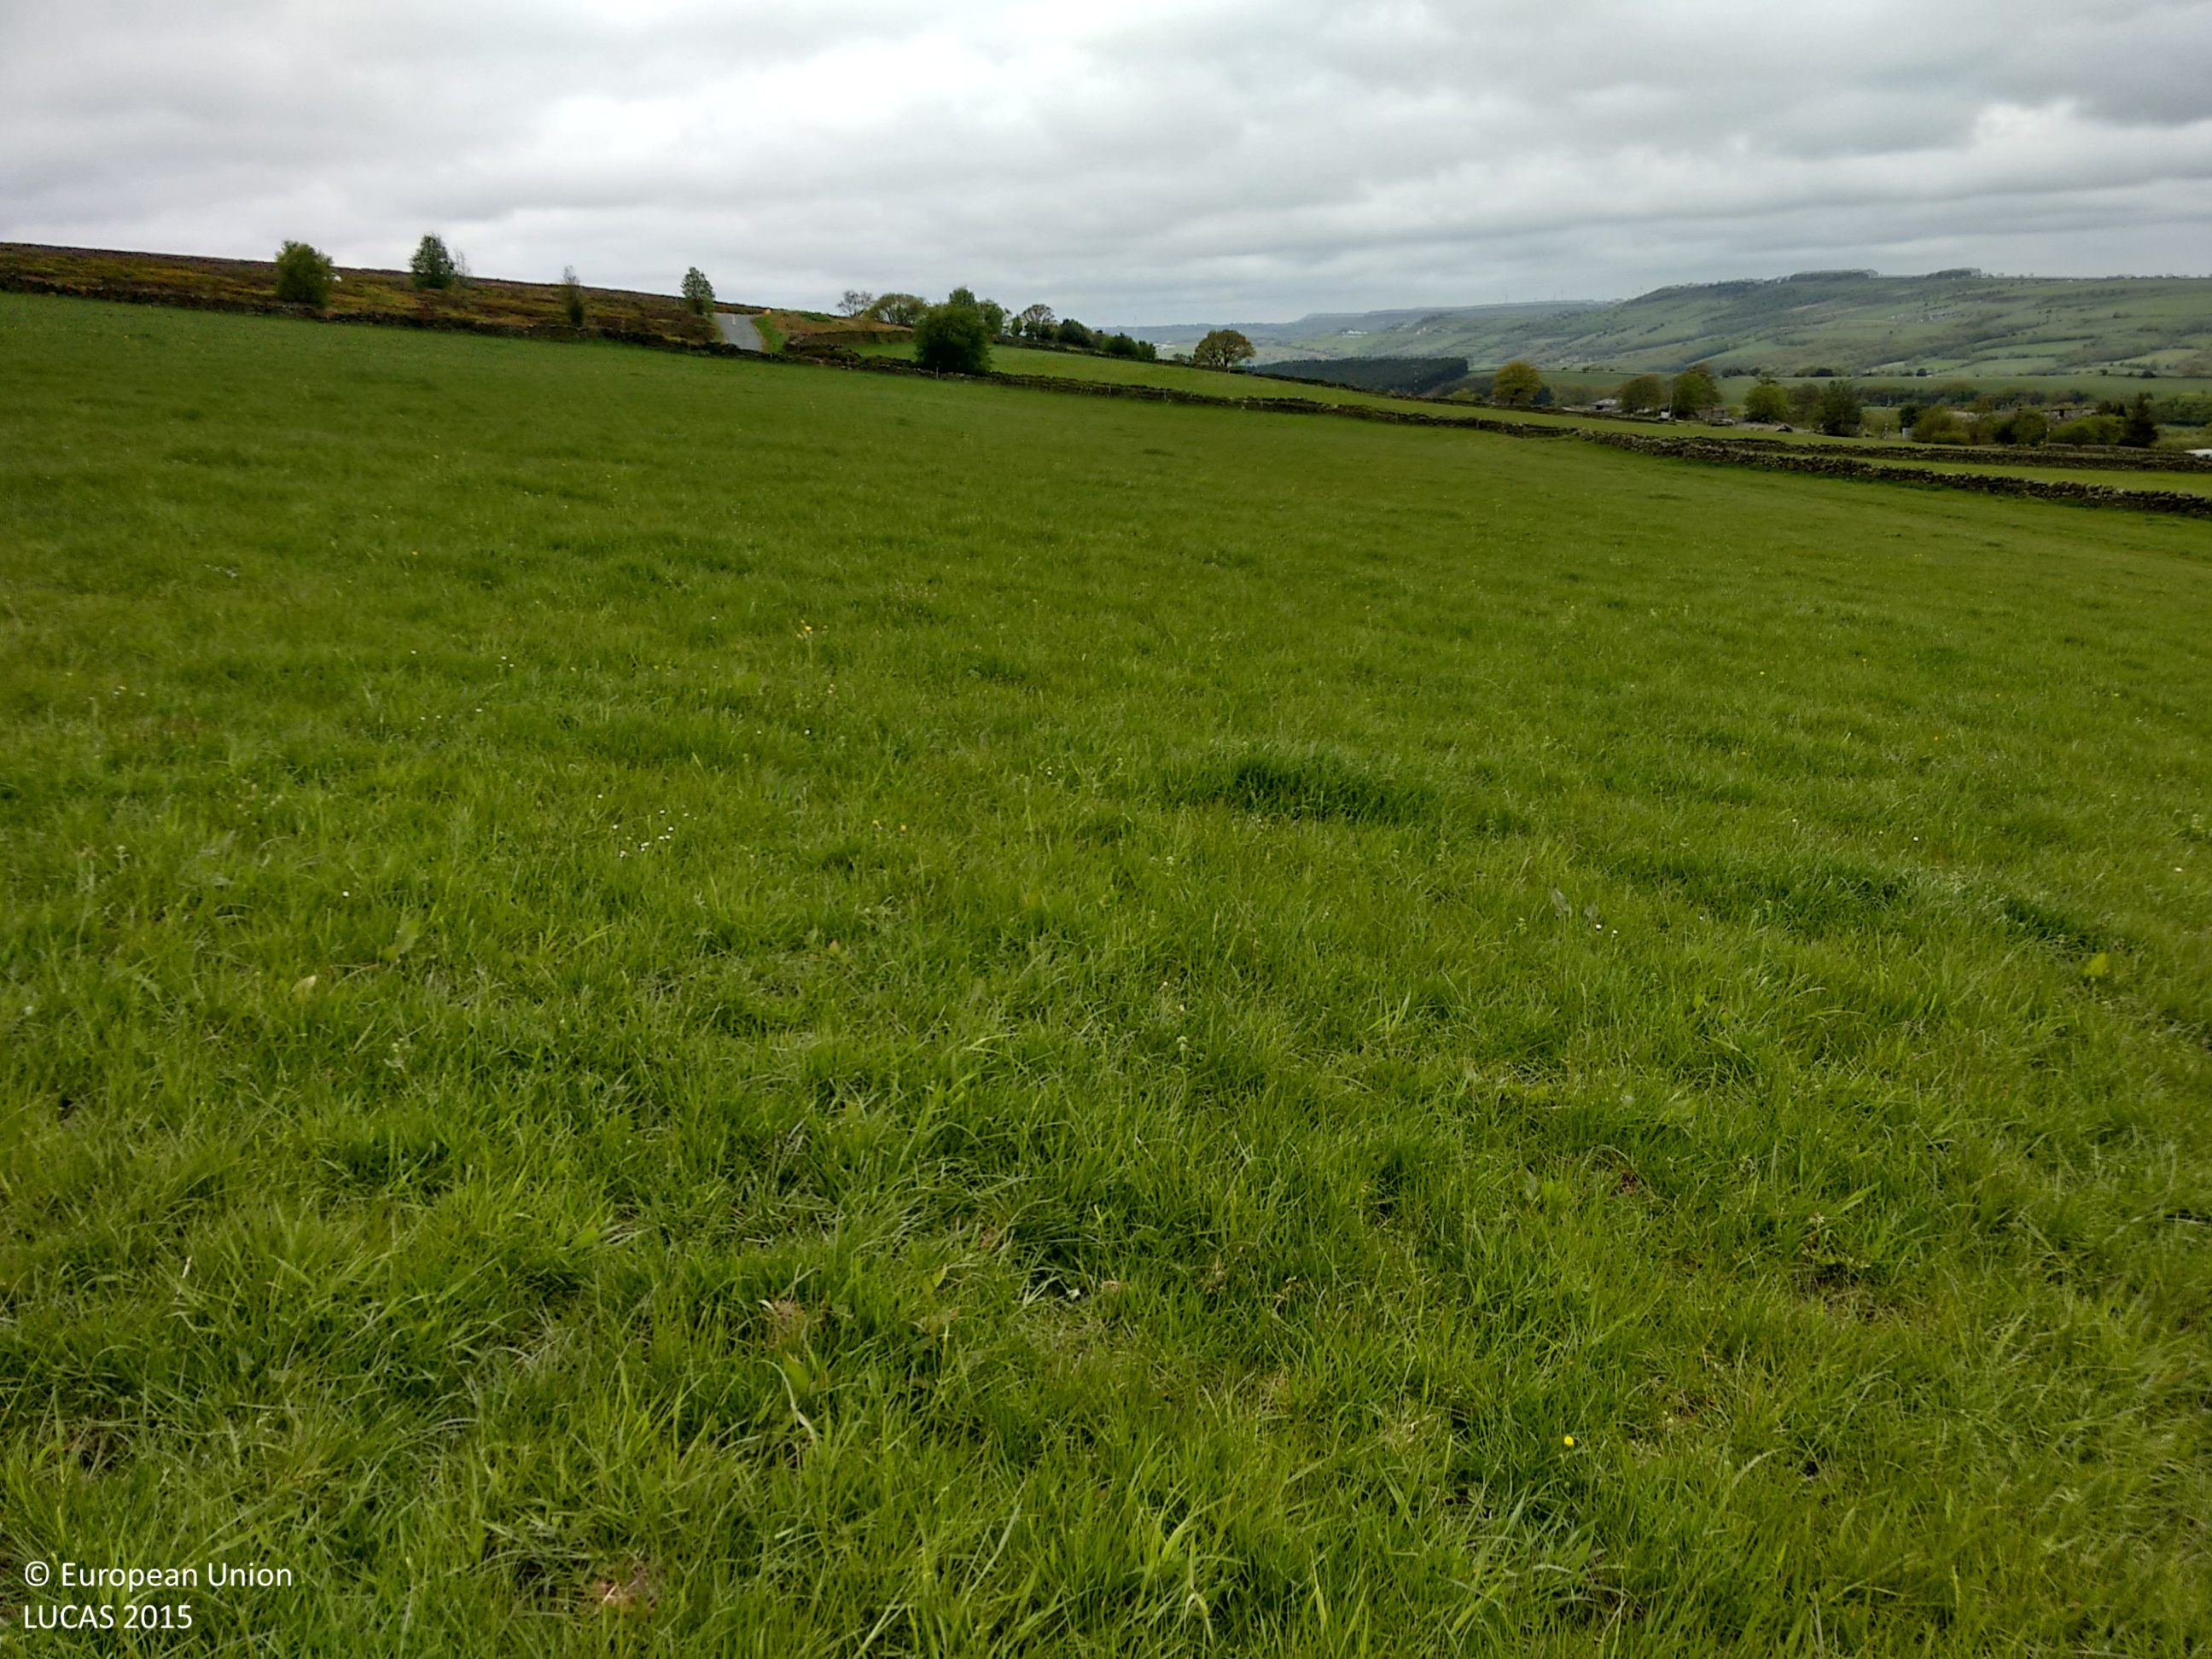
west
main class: Grassland
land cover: Grassland without tree/shrub cover
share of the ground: > 75 %
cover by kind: herbaceous plants 100 %
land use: Agriculture (excluding fallow land and kitchen gardens)
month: May
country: GB
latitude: 53.4746
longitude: -1.6382
